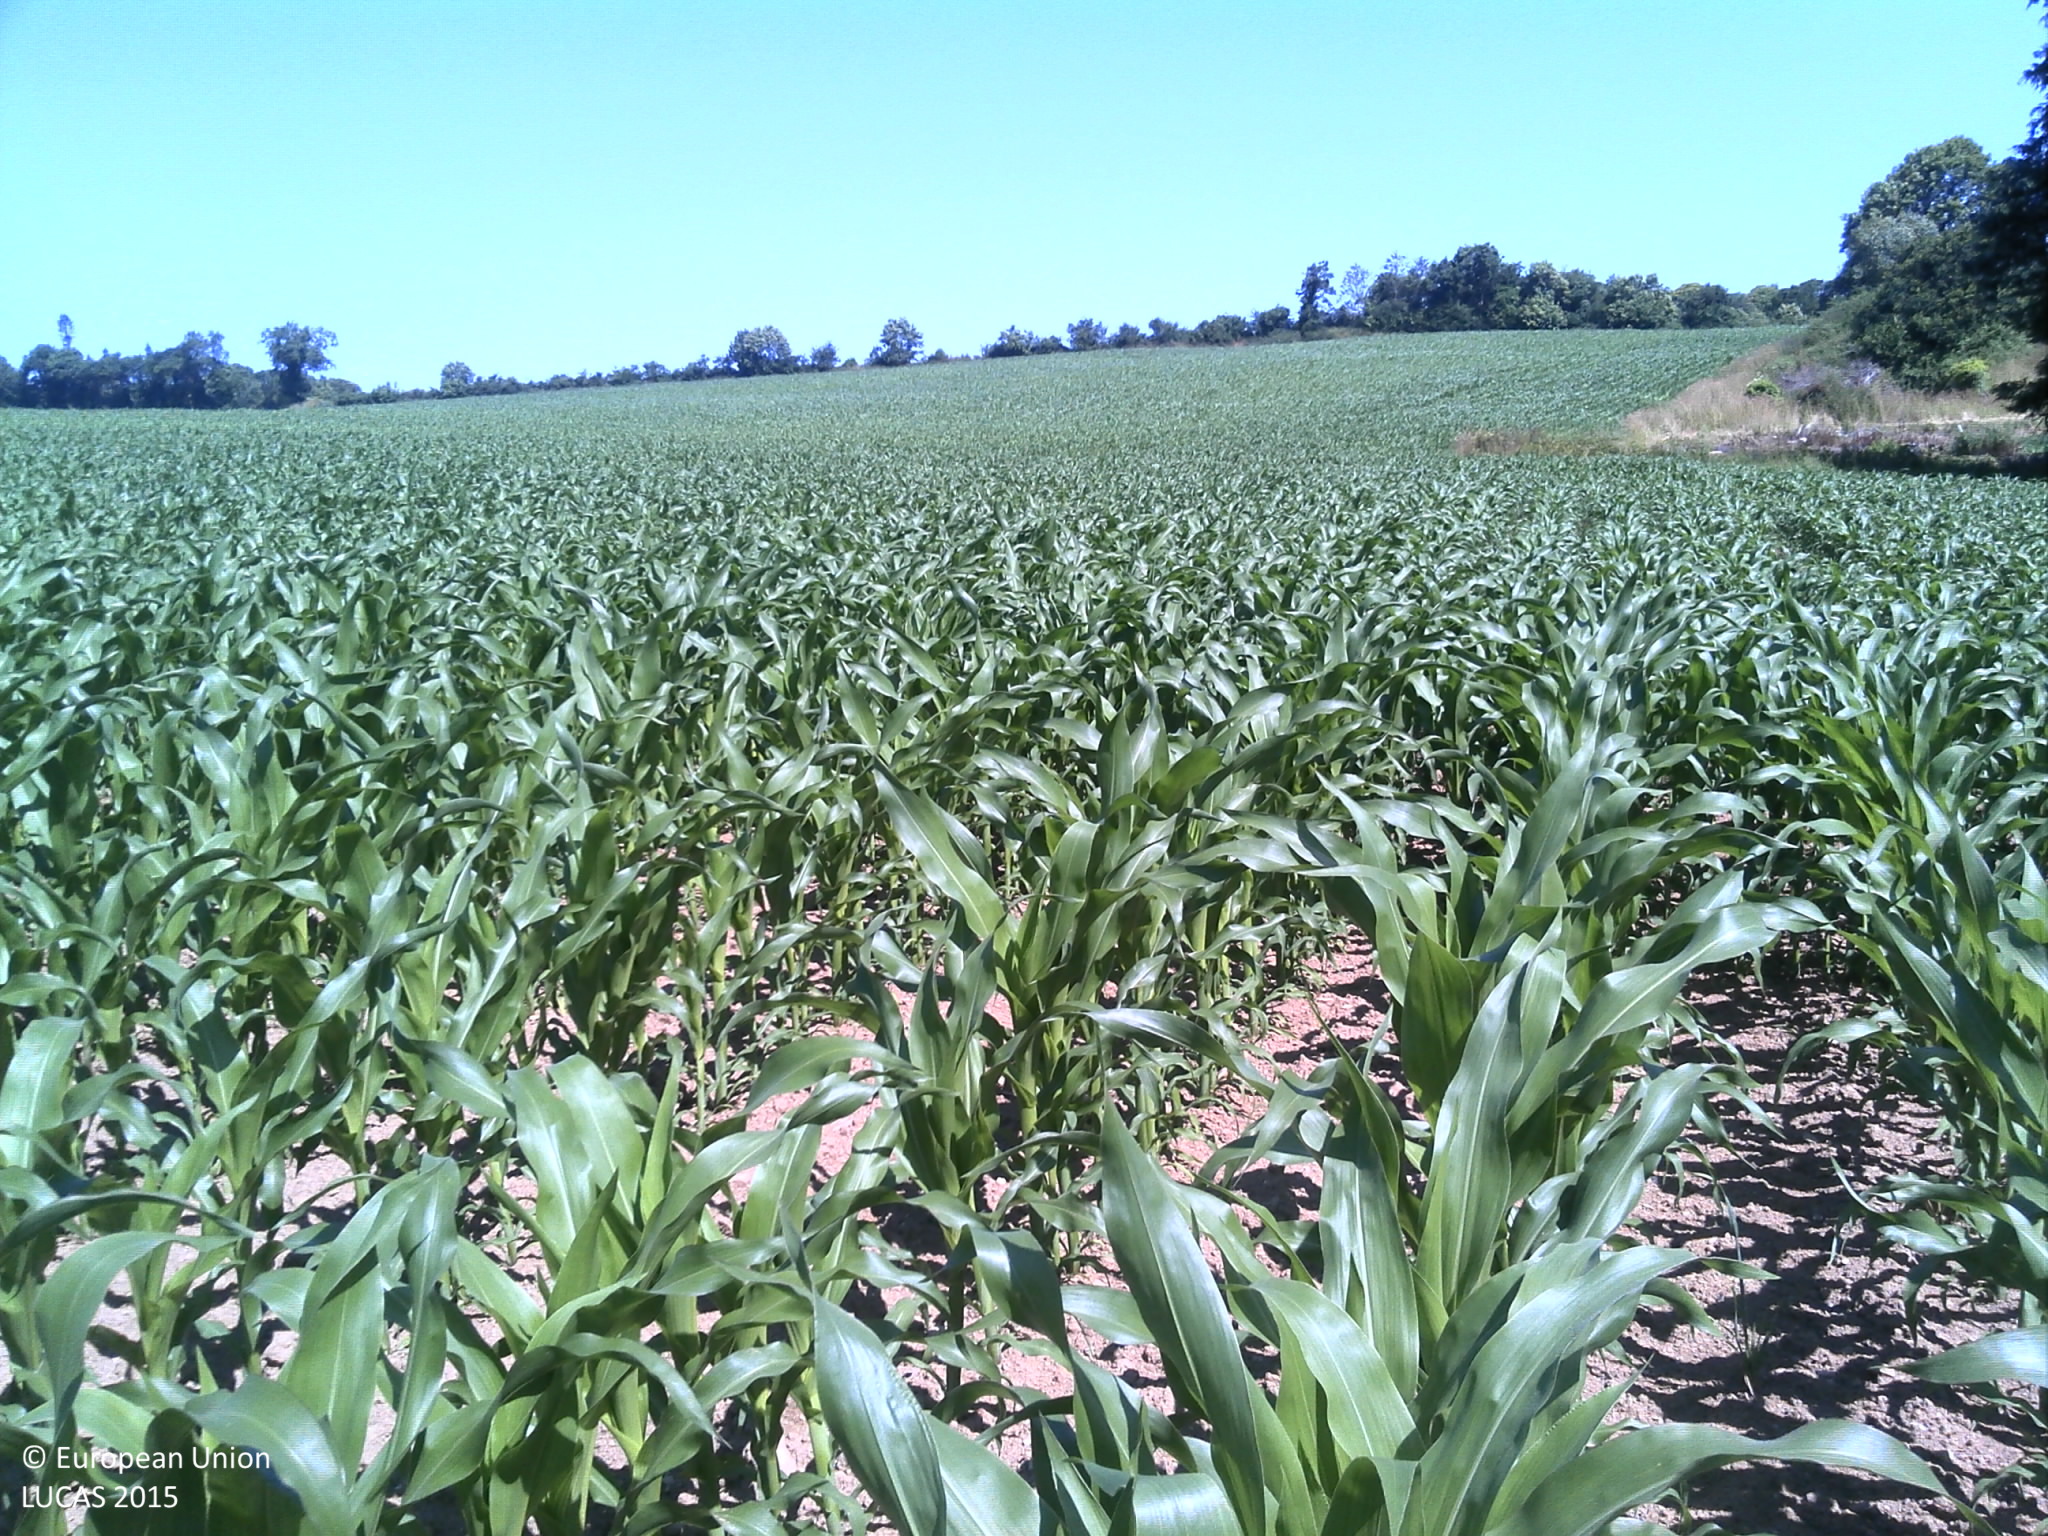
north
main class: Cropland
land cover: Maize
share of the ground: > 75 %
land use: Agriculture (excluding fallow land and kitchen gardens)
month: June
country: FR
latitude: 48.2321
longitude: -3.6101
